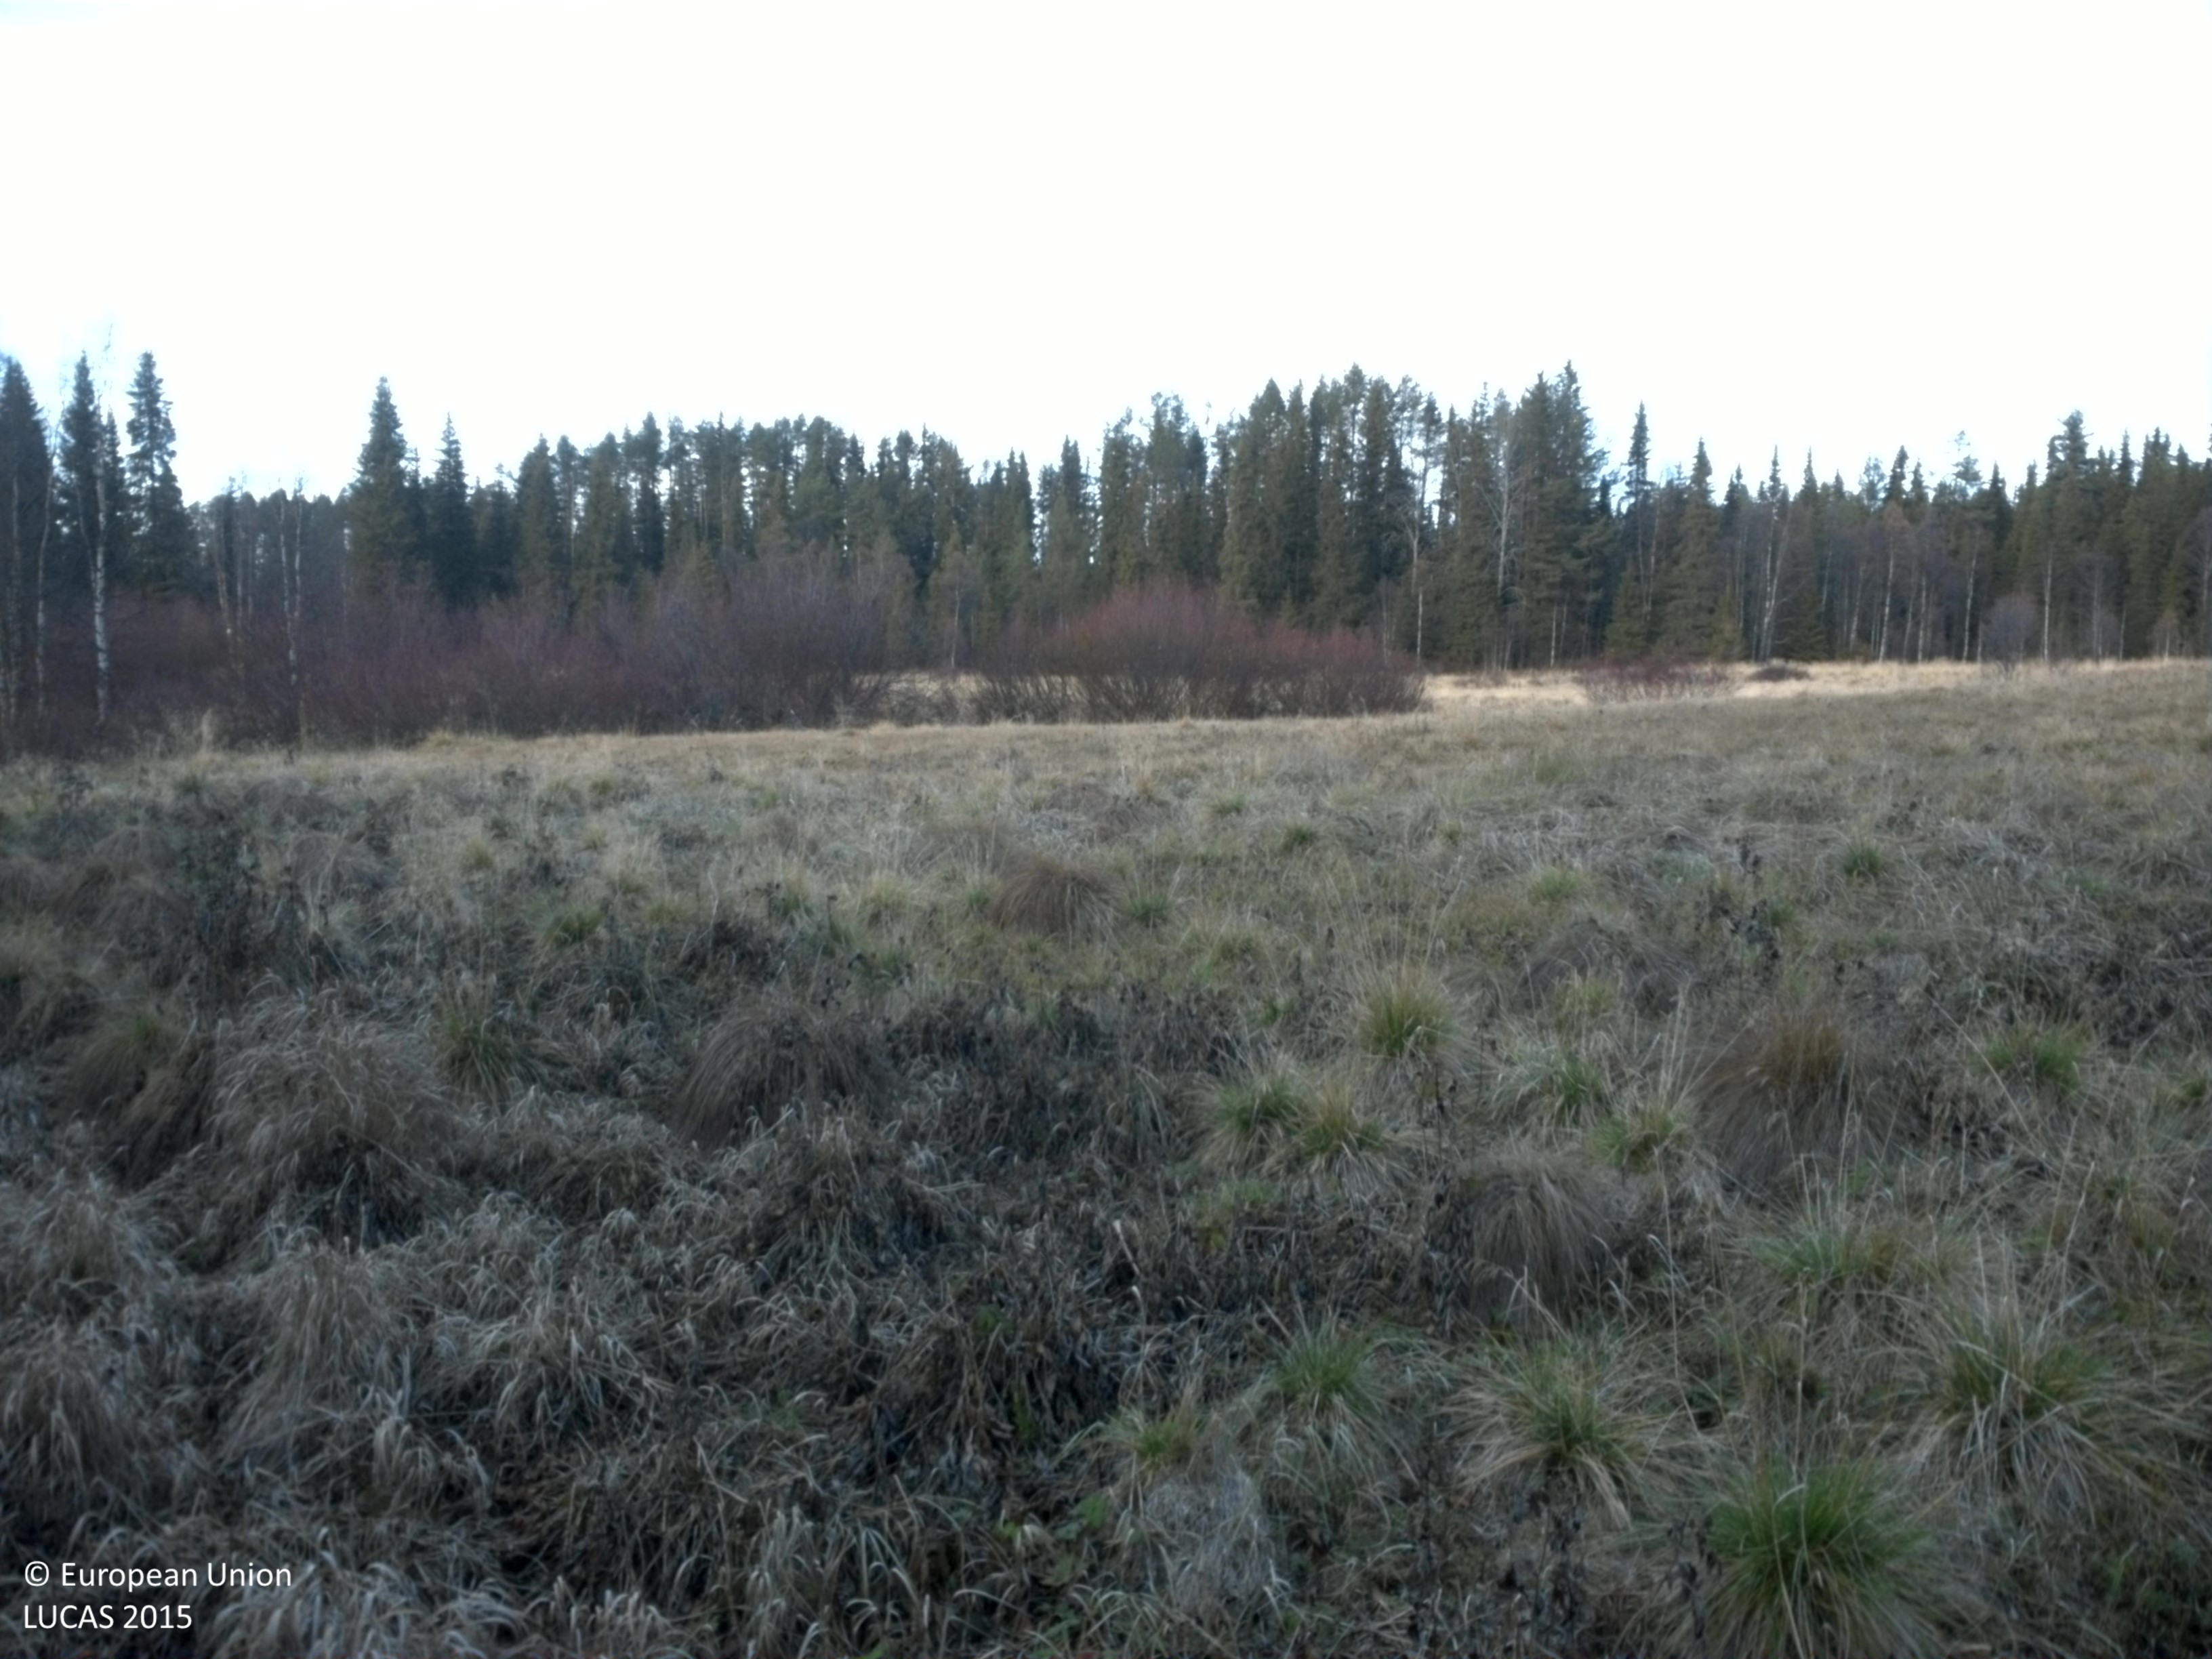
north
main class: Grassland
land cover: Grassland without tree/shrub cover
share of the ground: > 75 %
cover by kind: herbaceous plants 100 %
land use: Abandoned areas
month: October
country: SE
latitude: 64.6419
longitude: 17.0188
